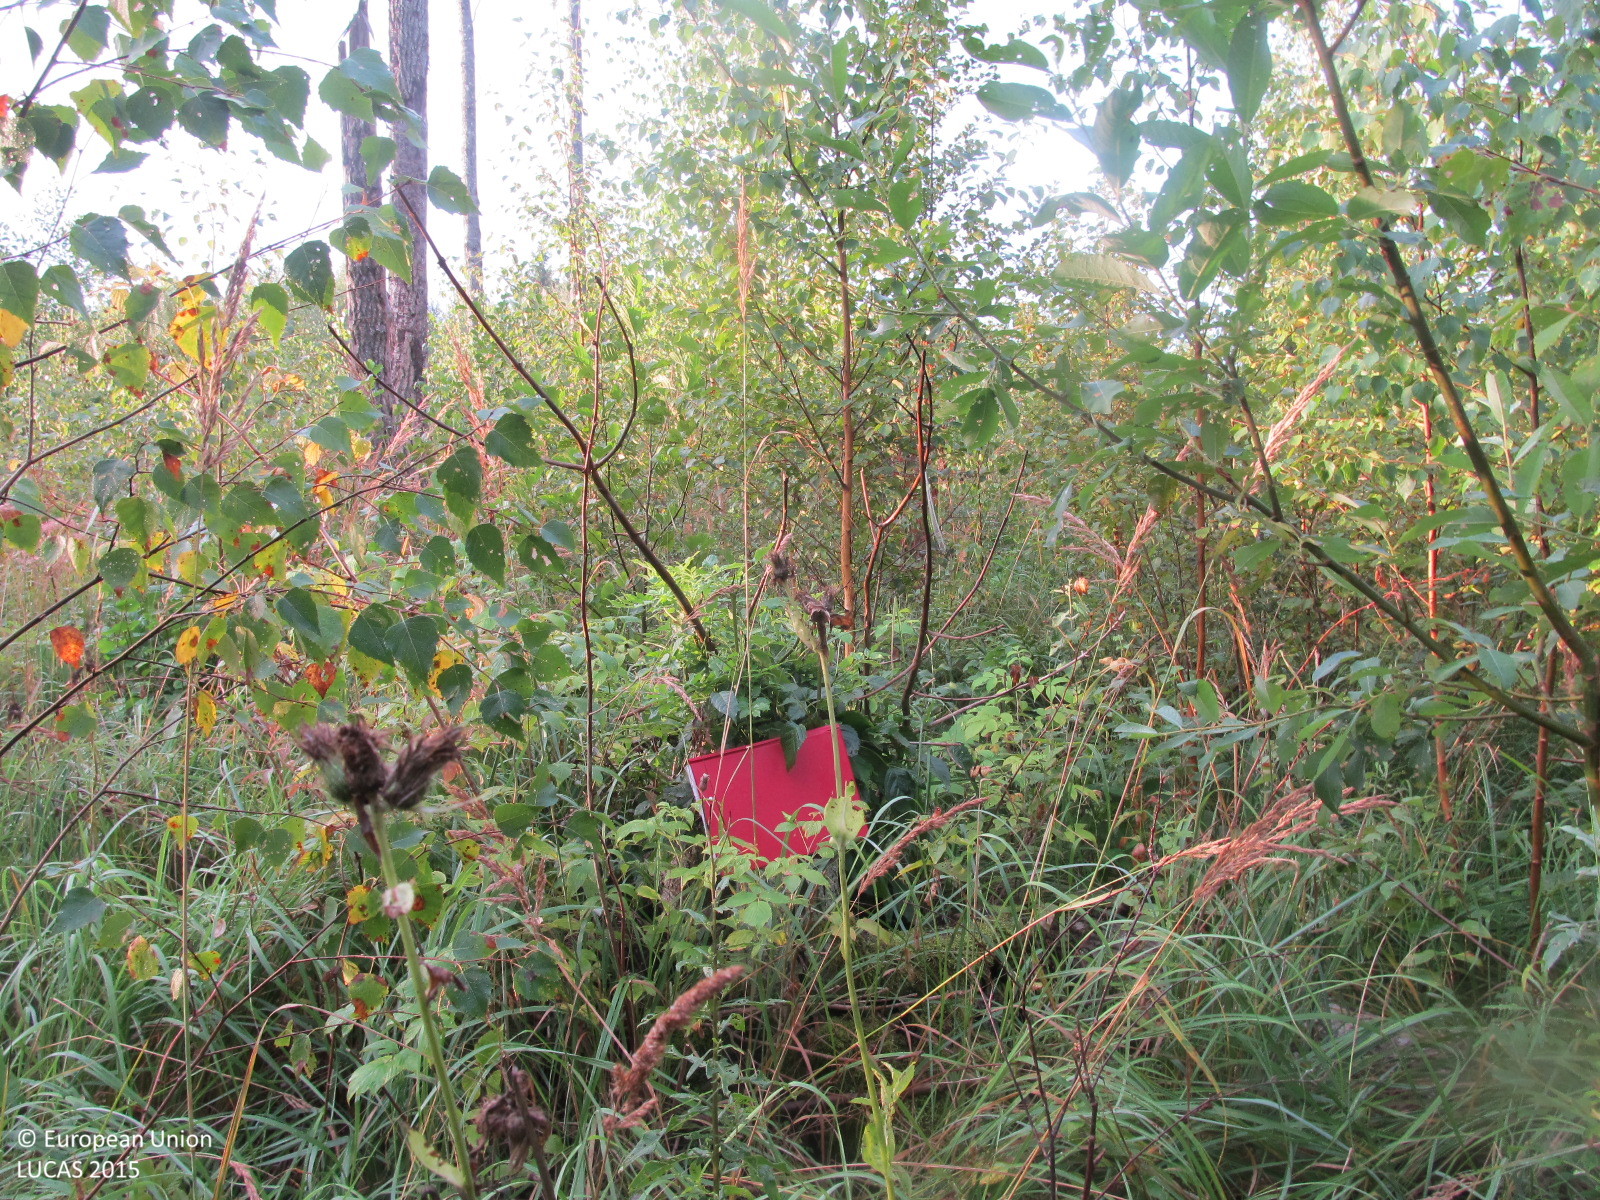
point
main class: Woodland
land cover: Broadleaved woodland
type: non-riverine alder, birch or aspen forest
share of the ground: > 75 %
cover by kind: broadleaved forest trees 75 %, shrubs 10 %, herbaceous plants 10 %, coniferous forest trees 5 %
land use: Forestry
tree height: < 5 m
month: September
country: LT
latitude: 56.0516
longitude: 23.3526
